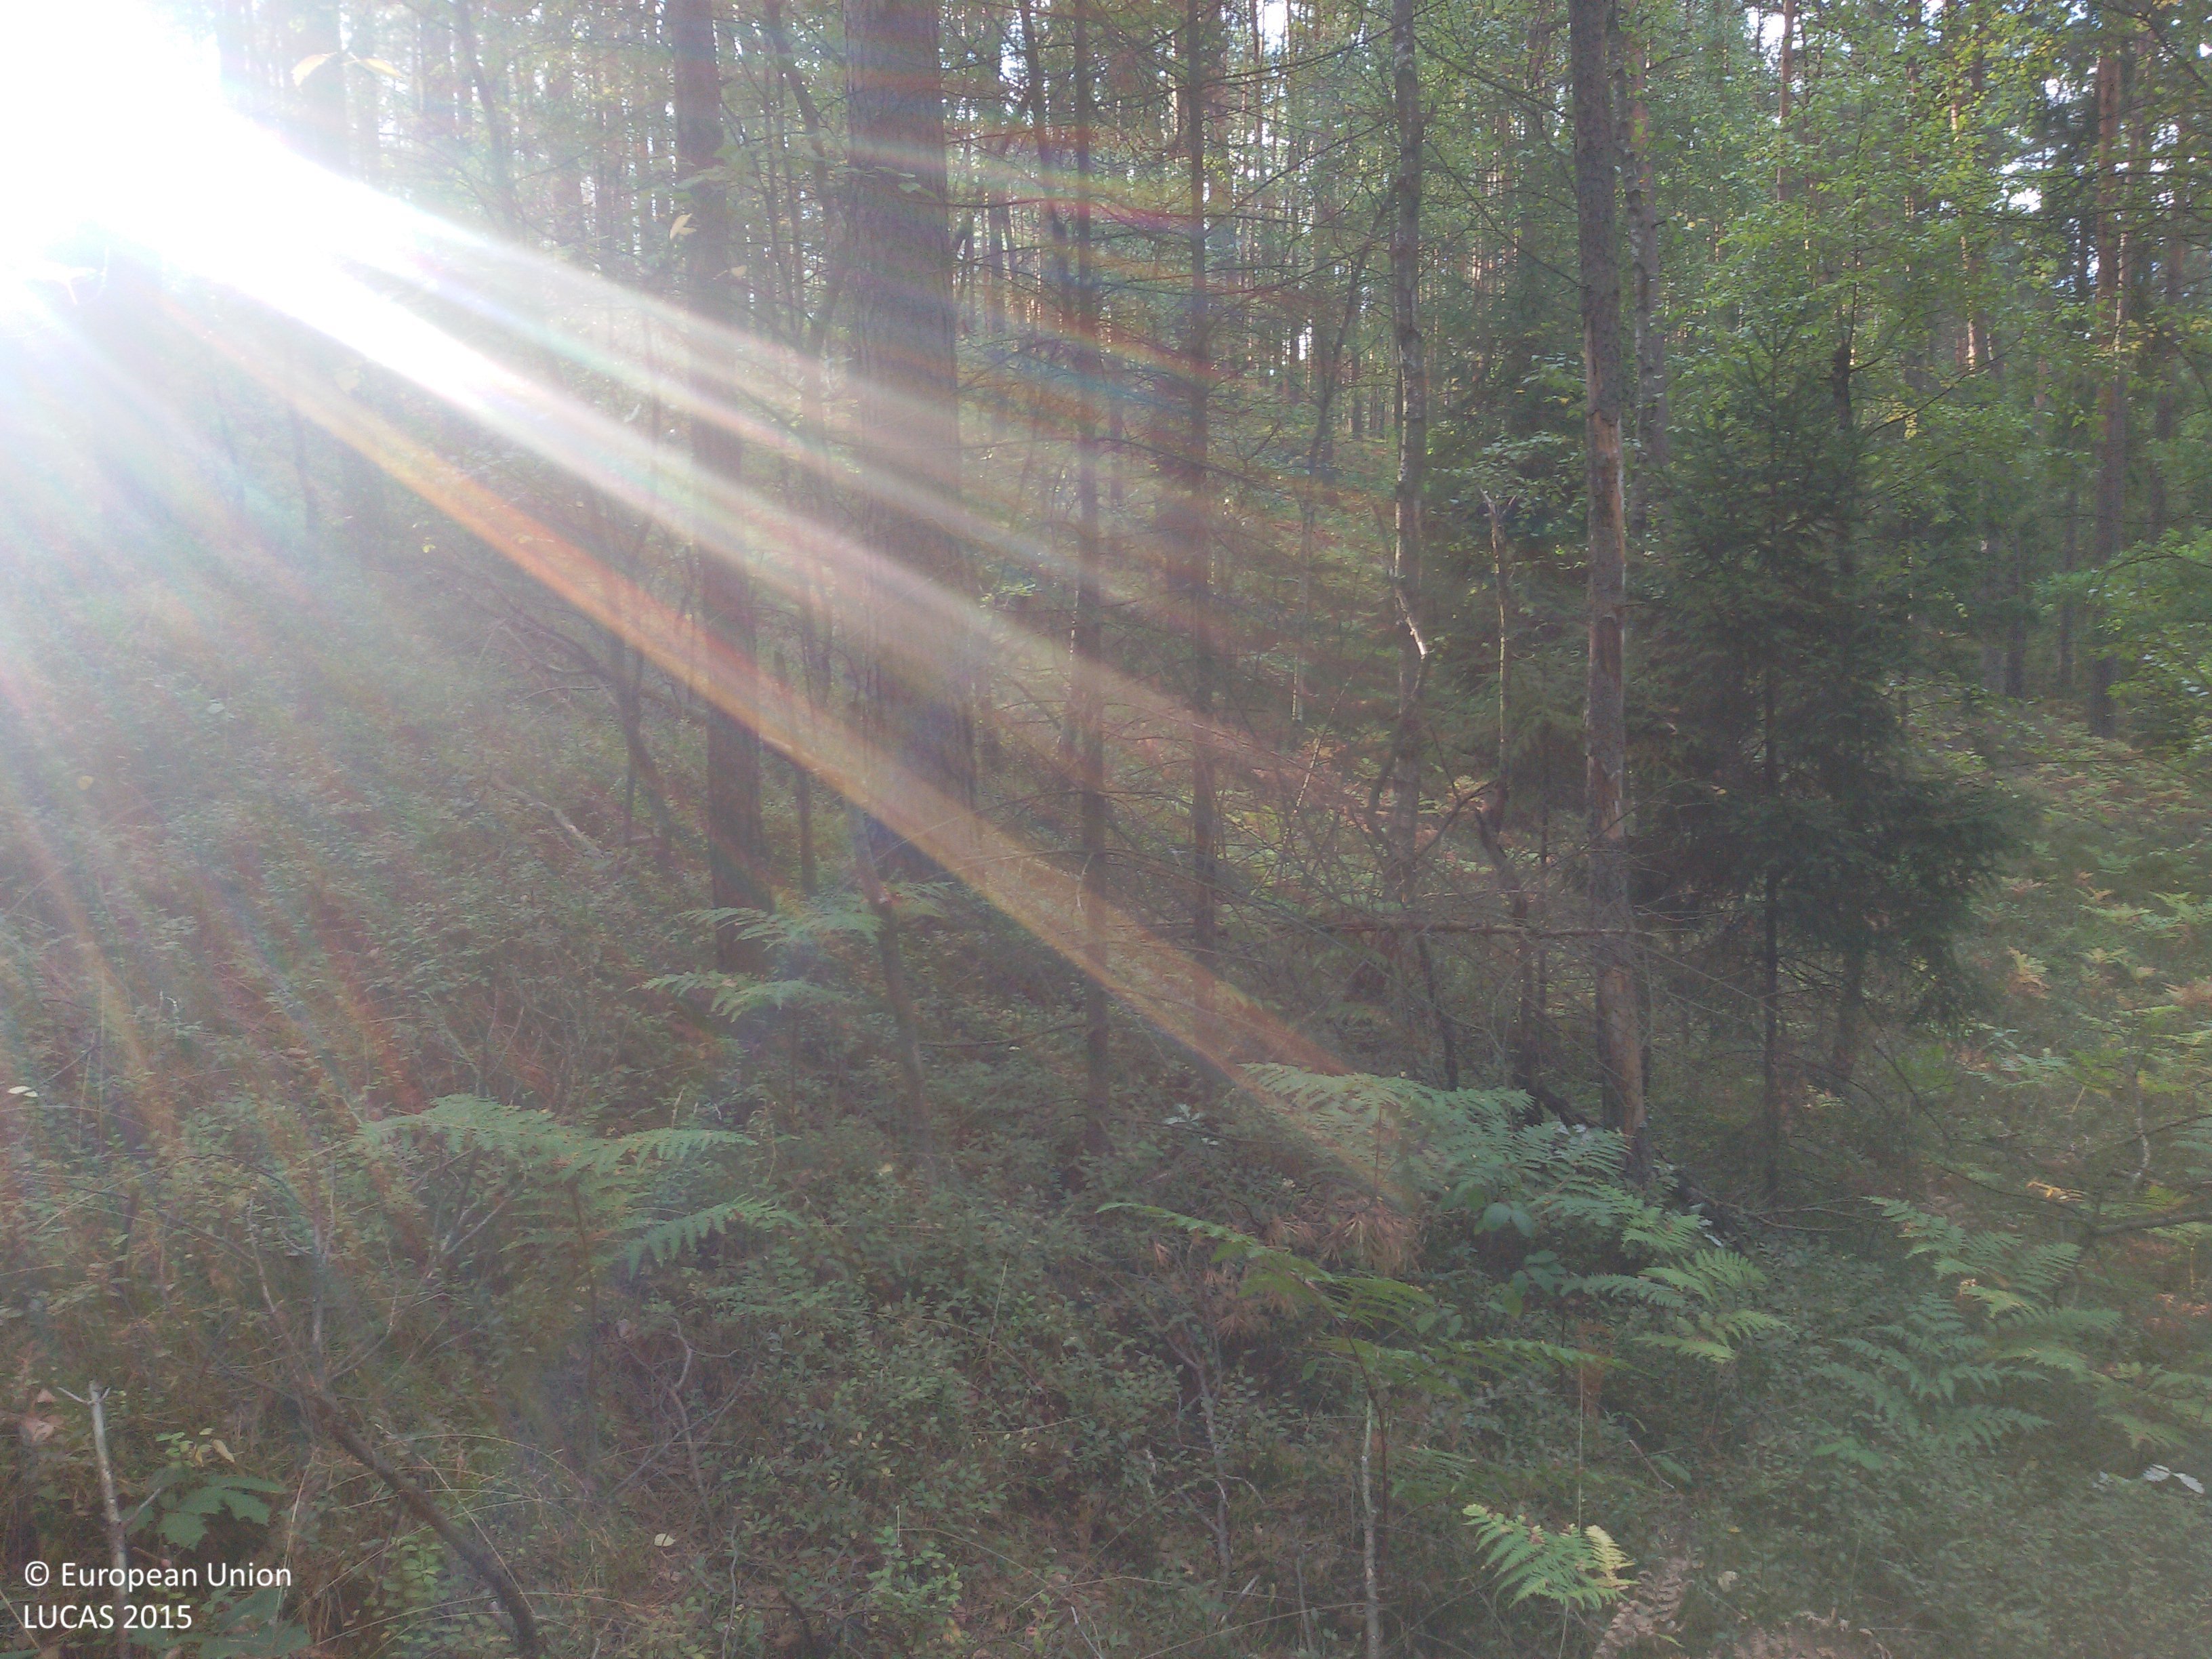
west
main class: Woodland
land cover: Pine dominated coniferous woodland
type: hemiboreal forest and nemoral coniferous forest and mixed broadleaved-coniferous forest
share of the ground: > 75 %
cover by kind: coniferous forest trees 75 %, herbaceous plants 15 %, lichens and mosses 10 %
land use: Forestry
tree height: > 5 m
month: September
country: PL
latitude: 50.7705
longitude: 18.7417
